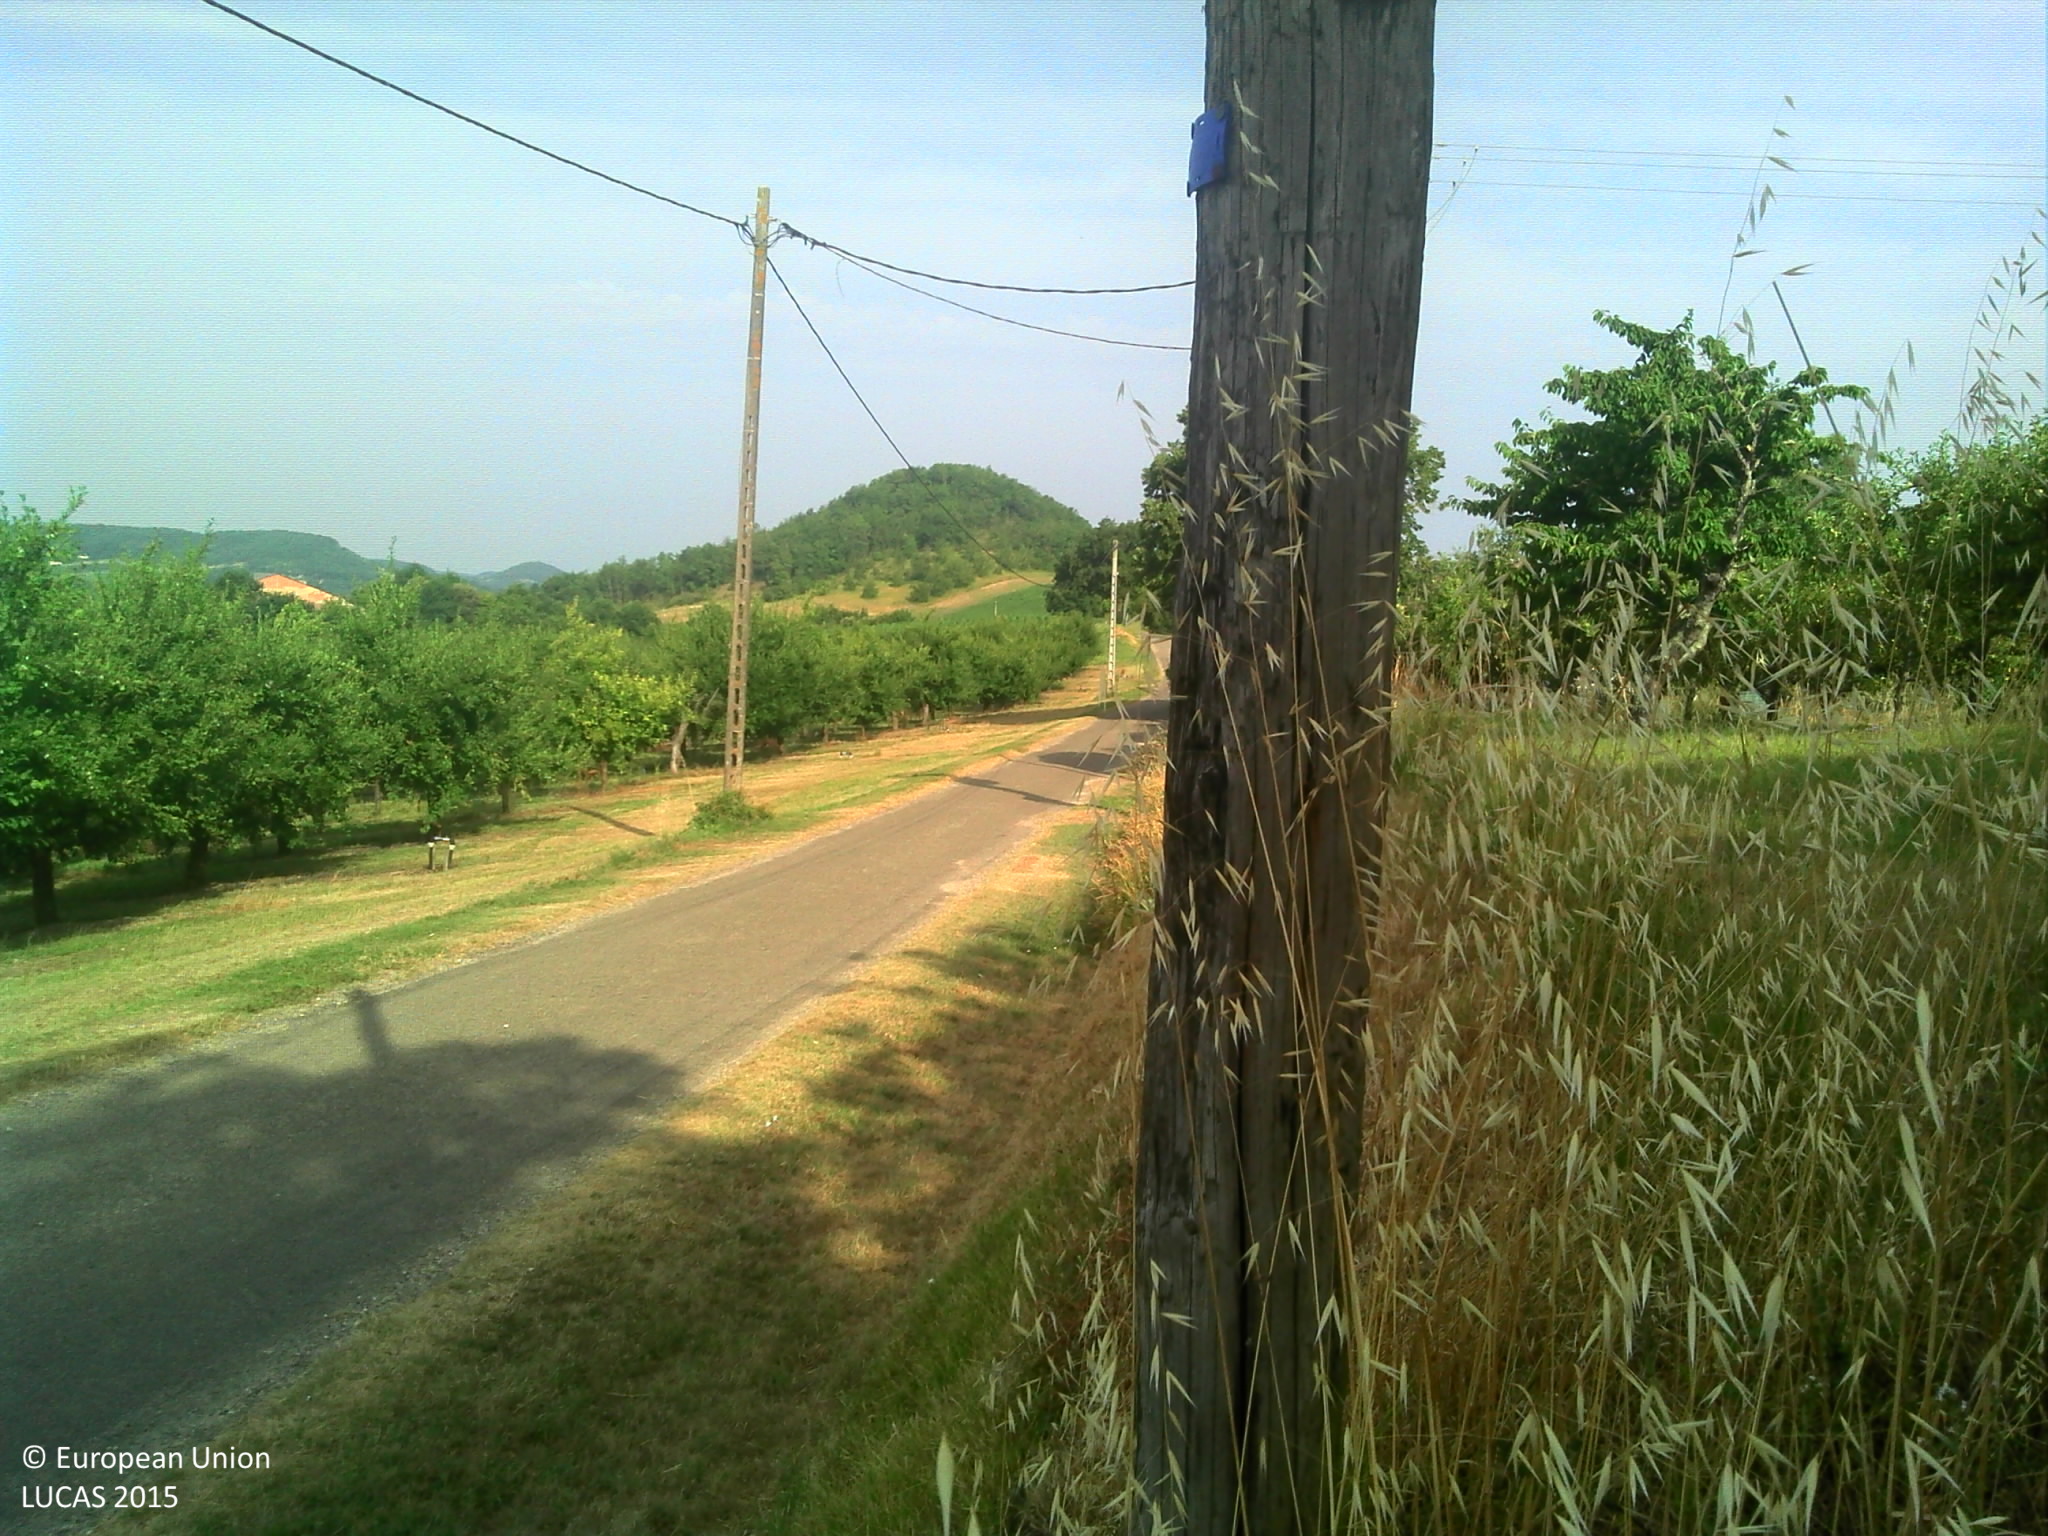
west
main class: Grassland
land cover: Grassland without tree/shrub cover
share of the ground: > 75 %
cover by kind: herbaceous plants 100 %
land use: Agriculture (excluding fallow land and kitchen gardens)
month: July
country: FR
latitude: 44.3692
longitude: 0.9228
